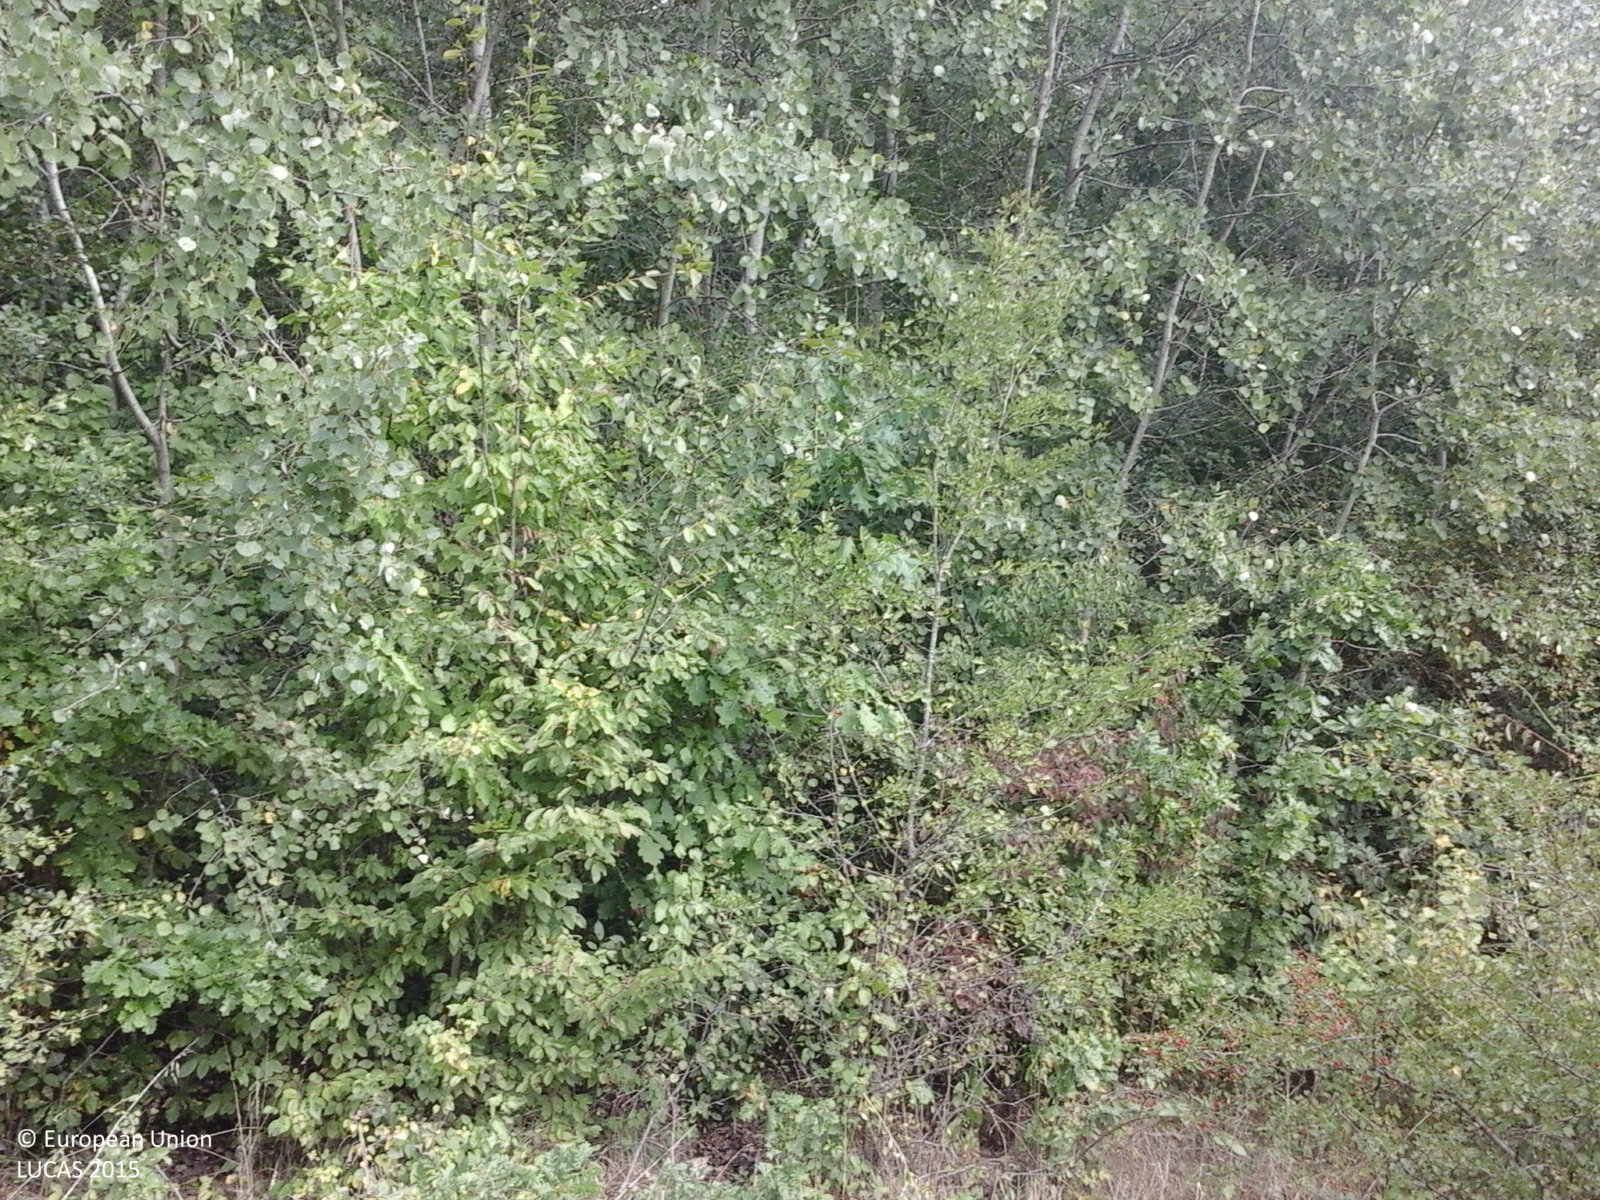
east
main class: Grassland
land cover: Grassland with sparse tree/shrub cover
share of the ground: > 75 %
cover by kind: herbaceous plants 85 %, shrubs 10 %, broadleaved forest trees 5 %
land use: Semi-natural and natural areas not in use
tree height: > 5 m
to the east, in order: Grassland with sparse tree/shrub cover; Broadleaved woodland
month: September
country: RO
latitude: 45.9462
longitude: 22.1564
